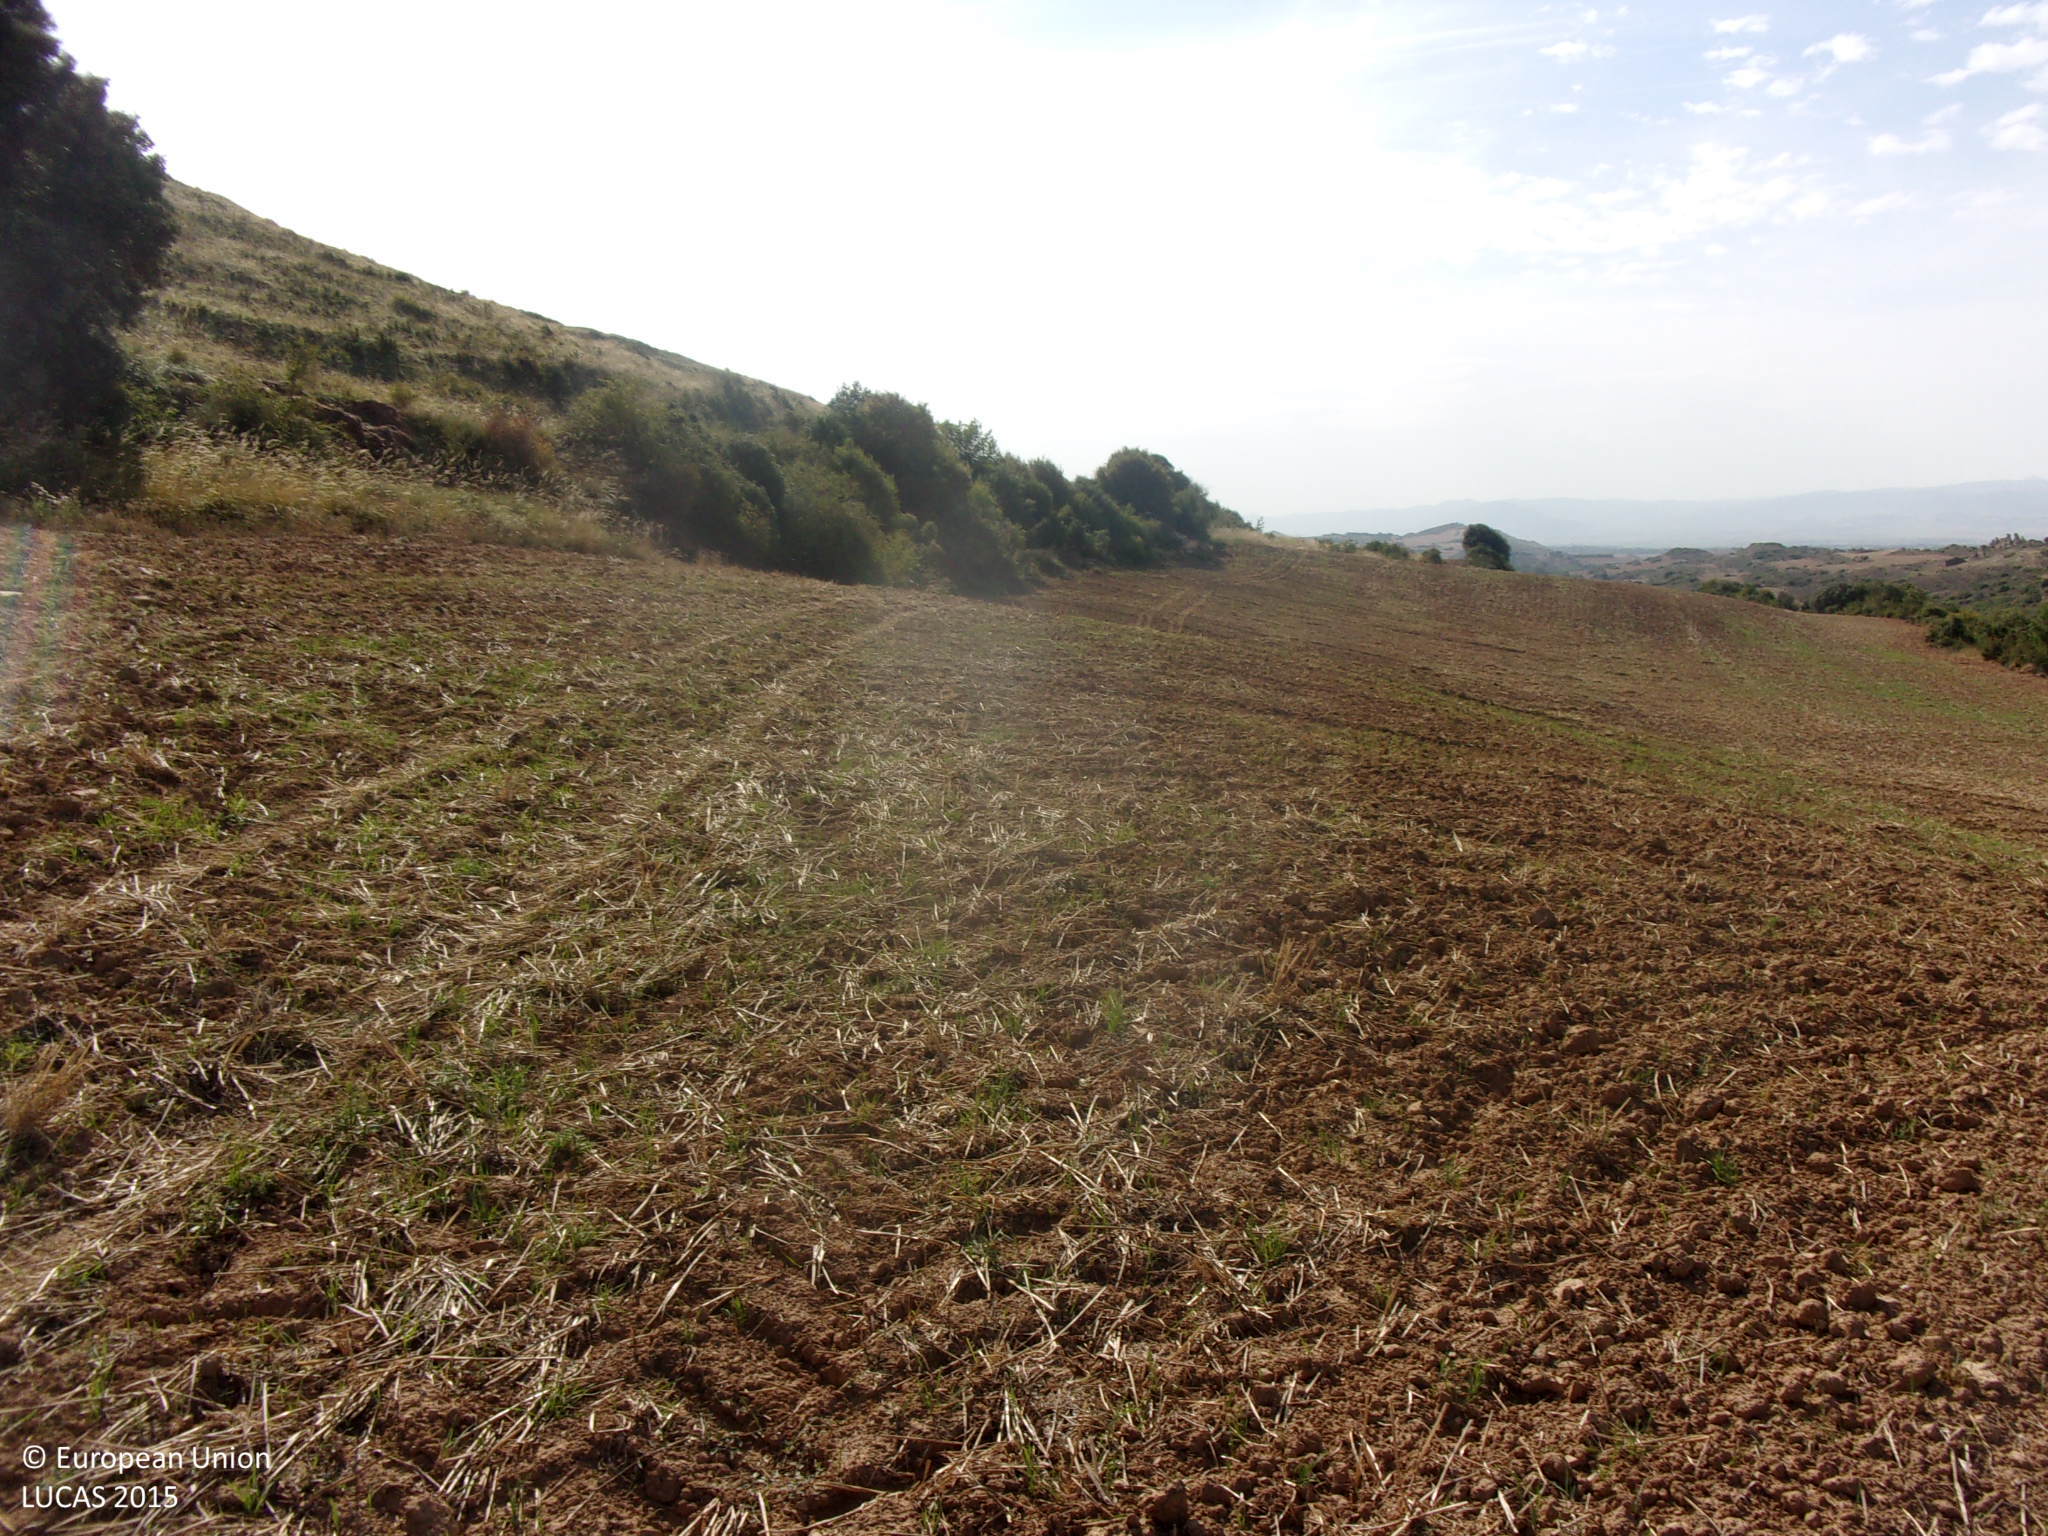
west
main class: Cropland
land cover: Common wheat
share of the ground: < 10 %
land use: Agriculture (excluding fallow land and kitchen gardens)
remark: Harvested field
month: August
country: ES
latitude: 42.5053
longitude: -1.1915
